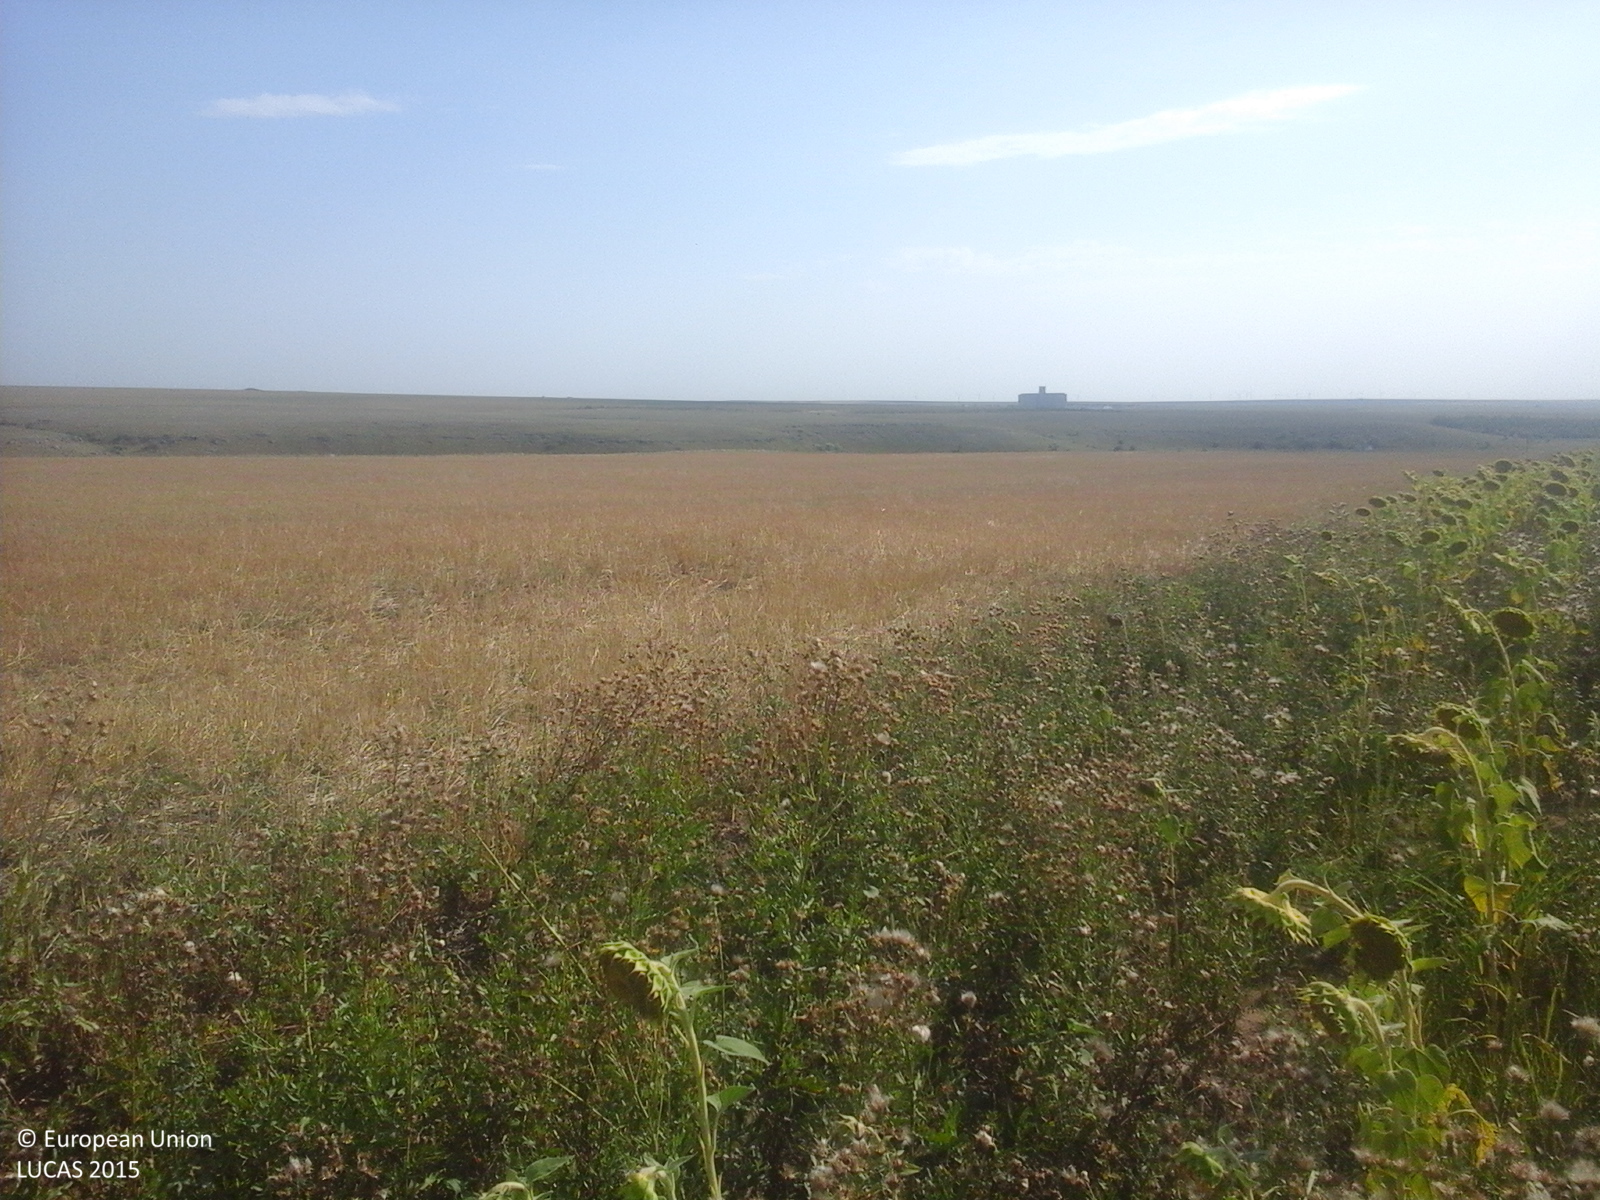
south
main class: Cropland
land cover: Sunflower
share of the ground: > 75 %
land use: Agriculture (excluding fallow land and kitchen gardens)
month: August
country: RO
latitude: 44.0015
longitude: 28.2812
